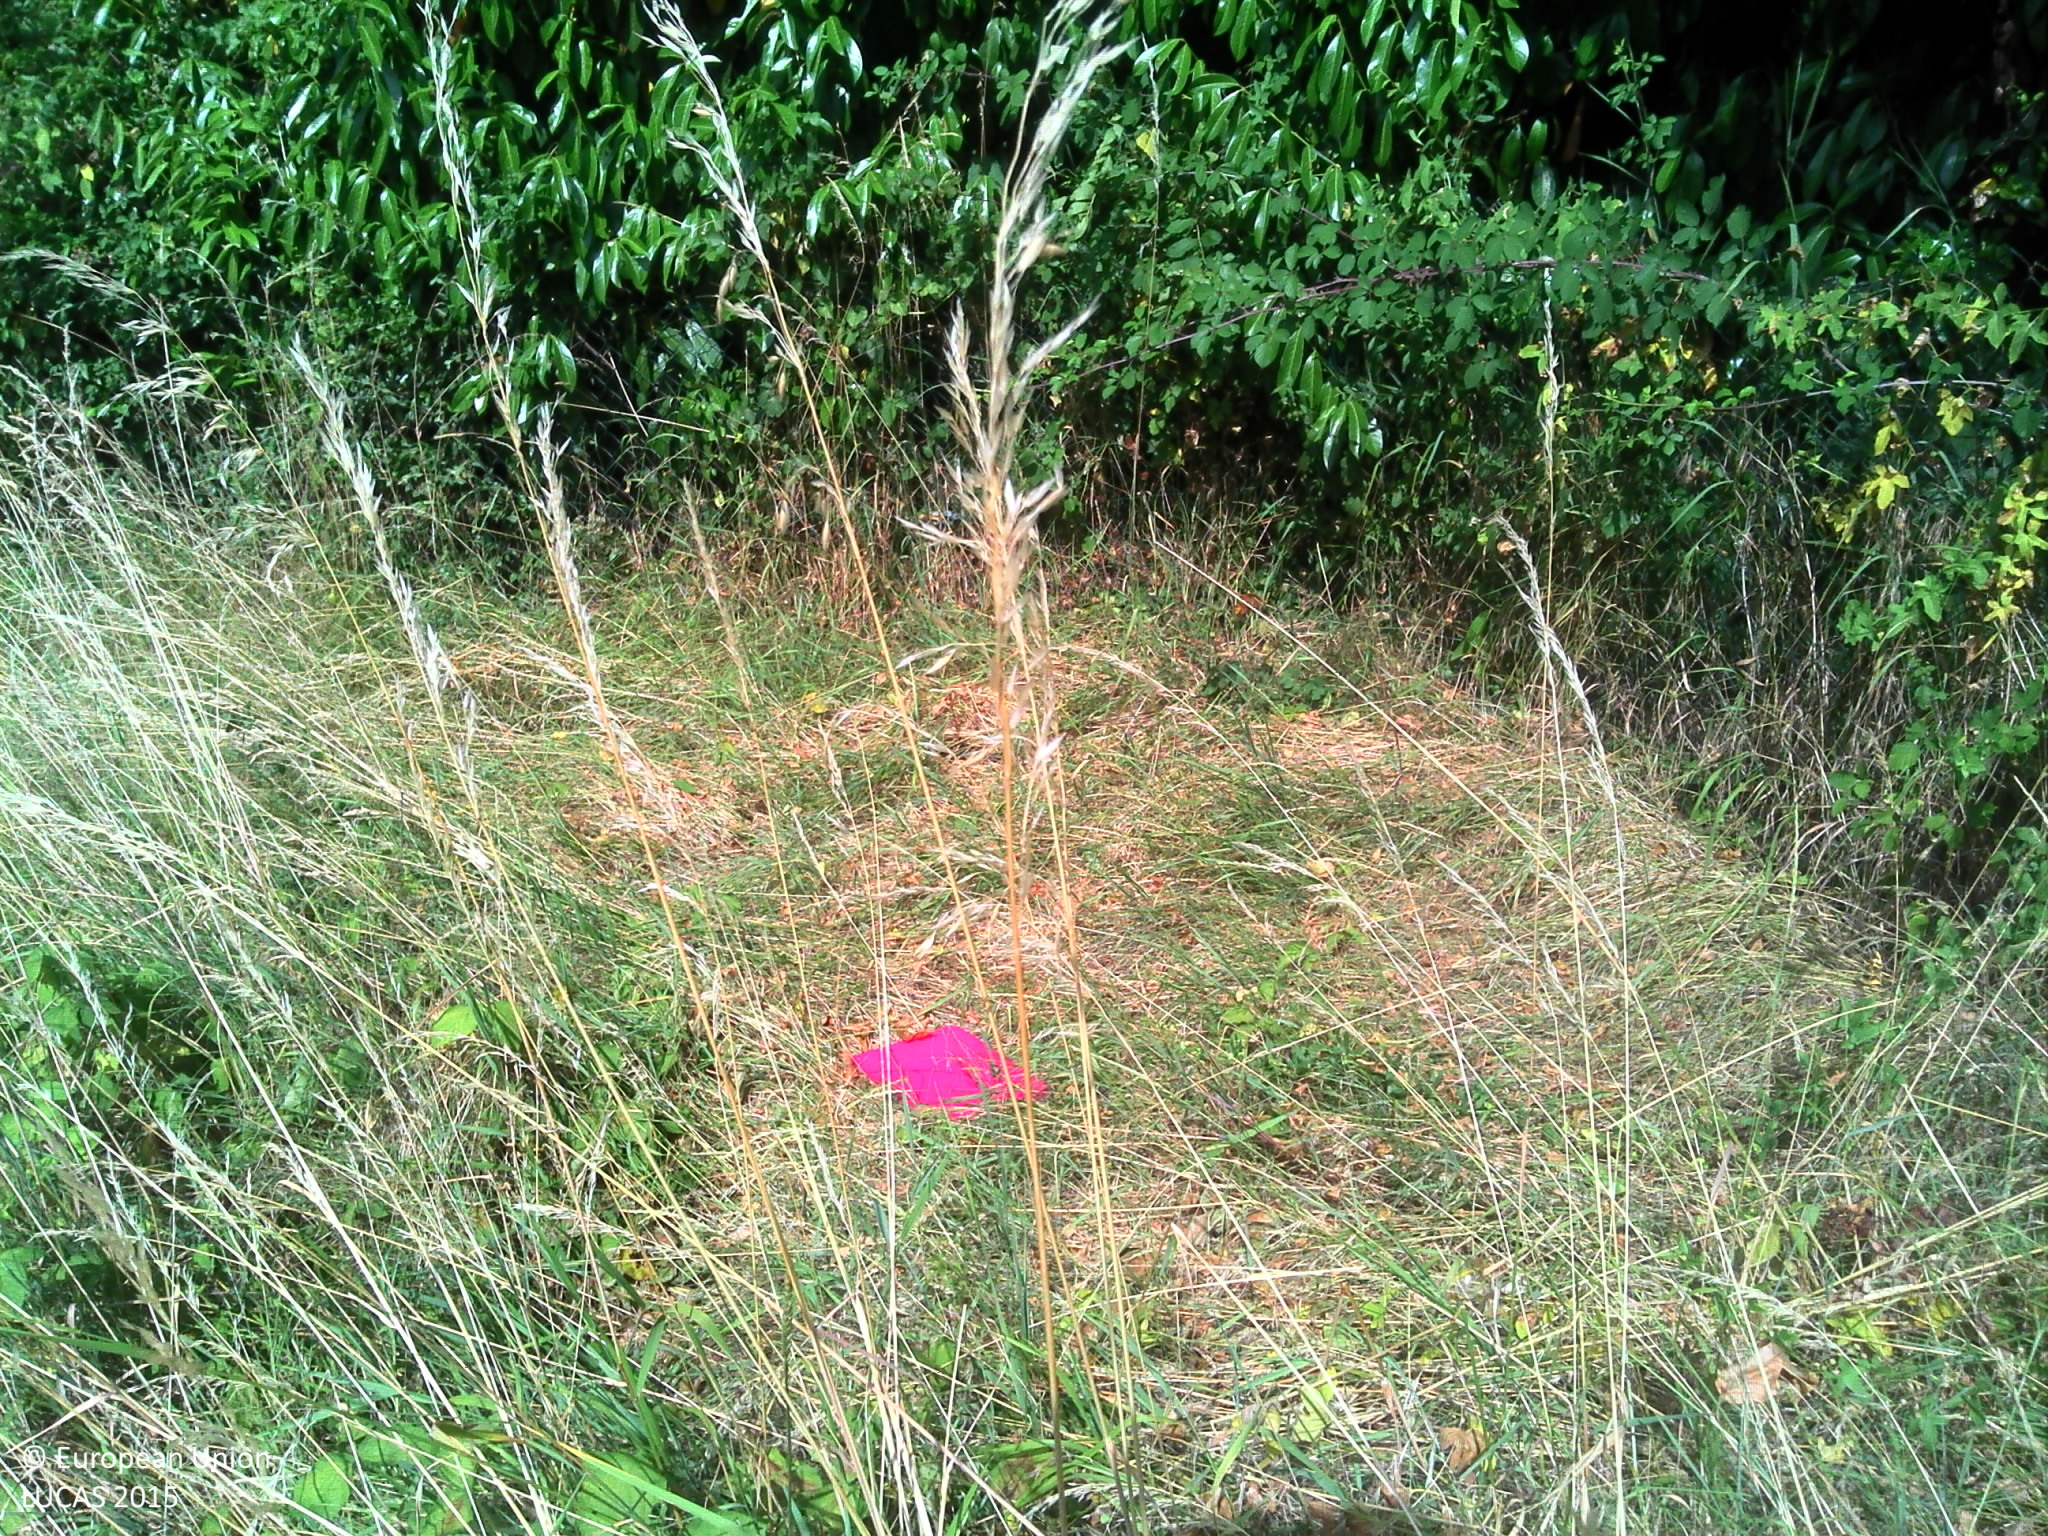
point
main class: Grassland
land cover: Grassland without tree/shrub cover
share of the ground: > 75 %
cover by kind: herbaceous plants 100 %
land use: Residential
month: July
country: FR
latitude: 46.1776
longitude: 6.2598
